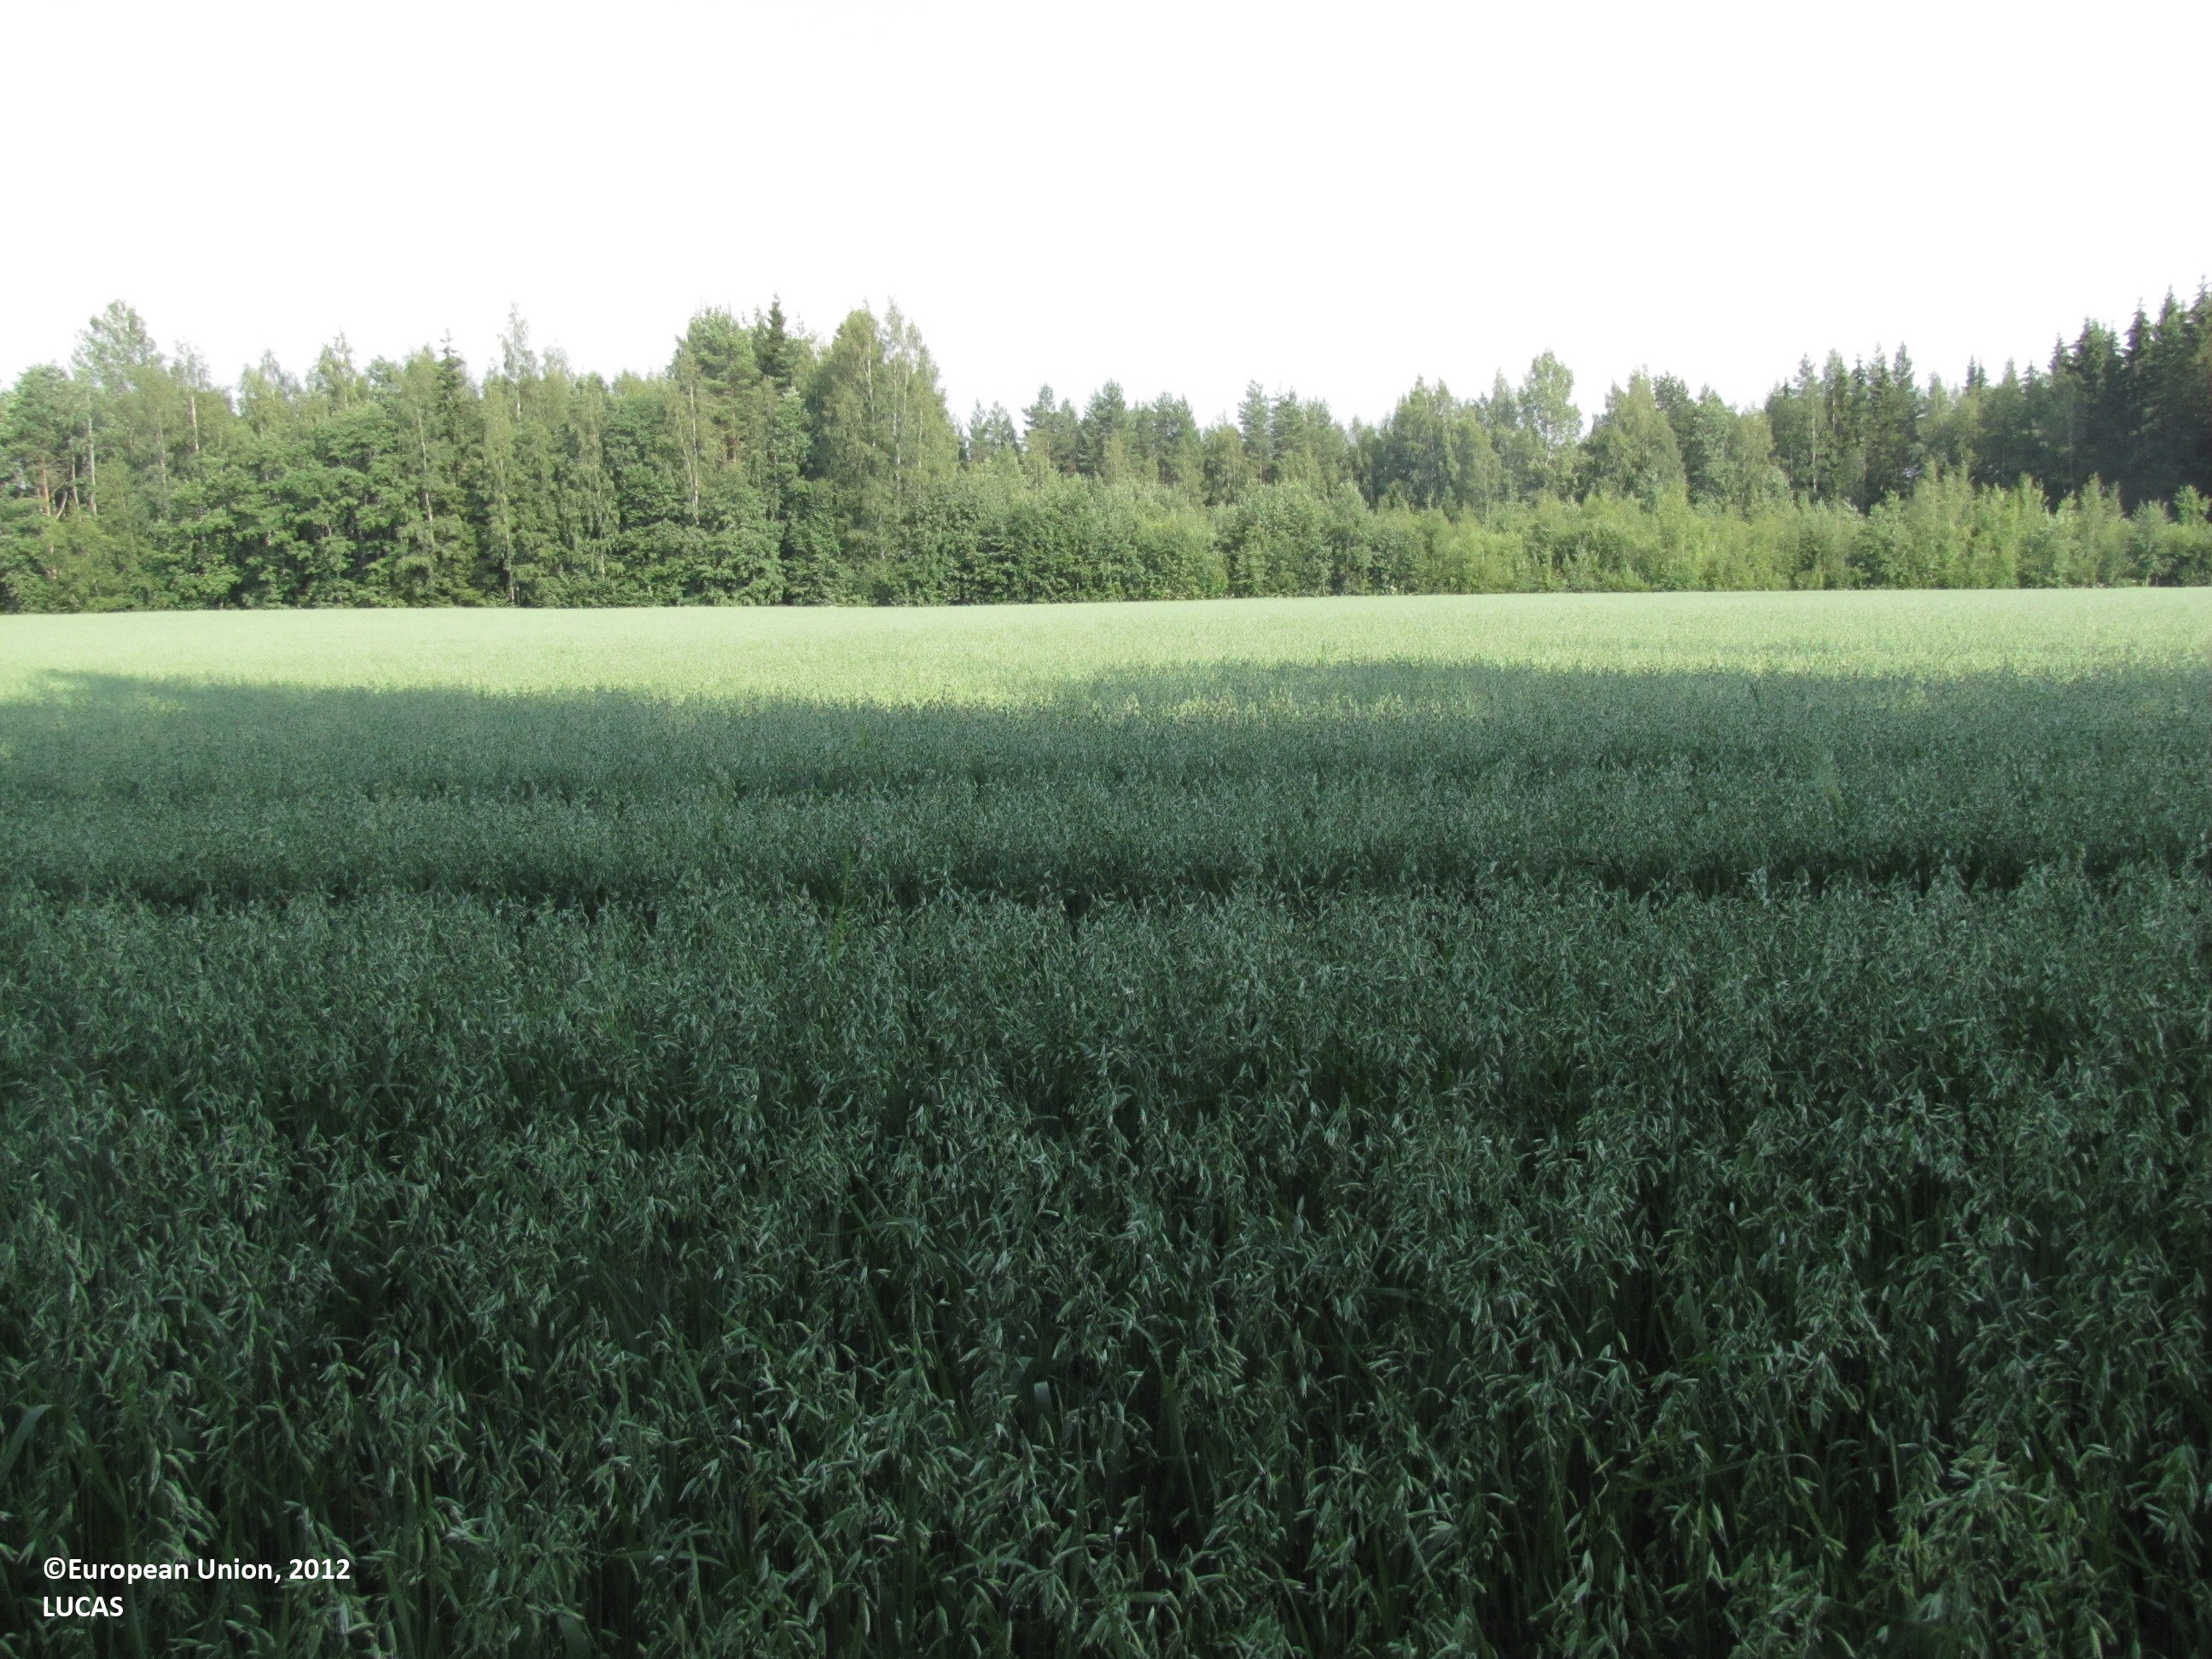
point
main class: Cropland
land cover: Oats
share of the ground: > 75 %
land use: Agriculture (excluding fallow land and kitchen gardens)
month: July
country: FI
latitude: 61.9564
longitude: 22.9751
